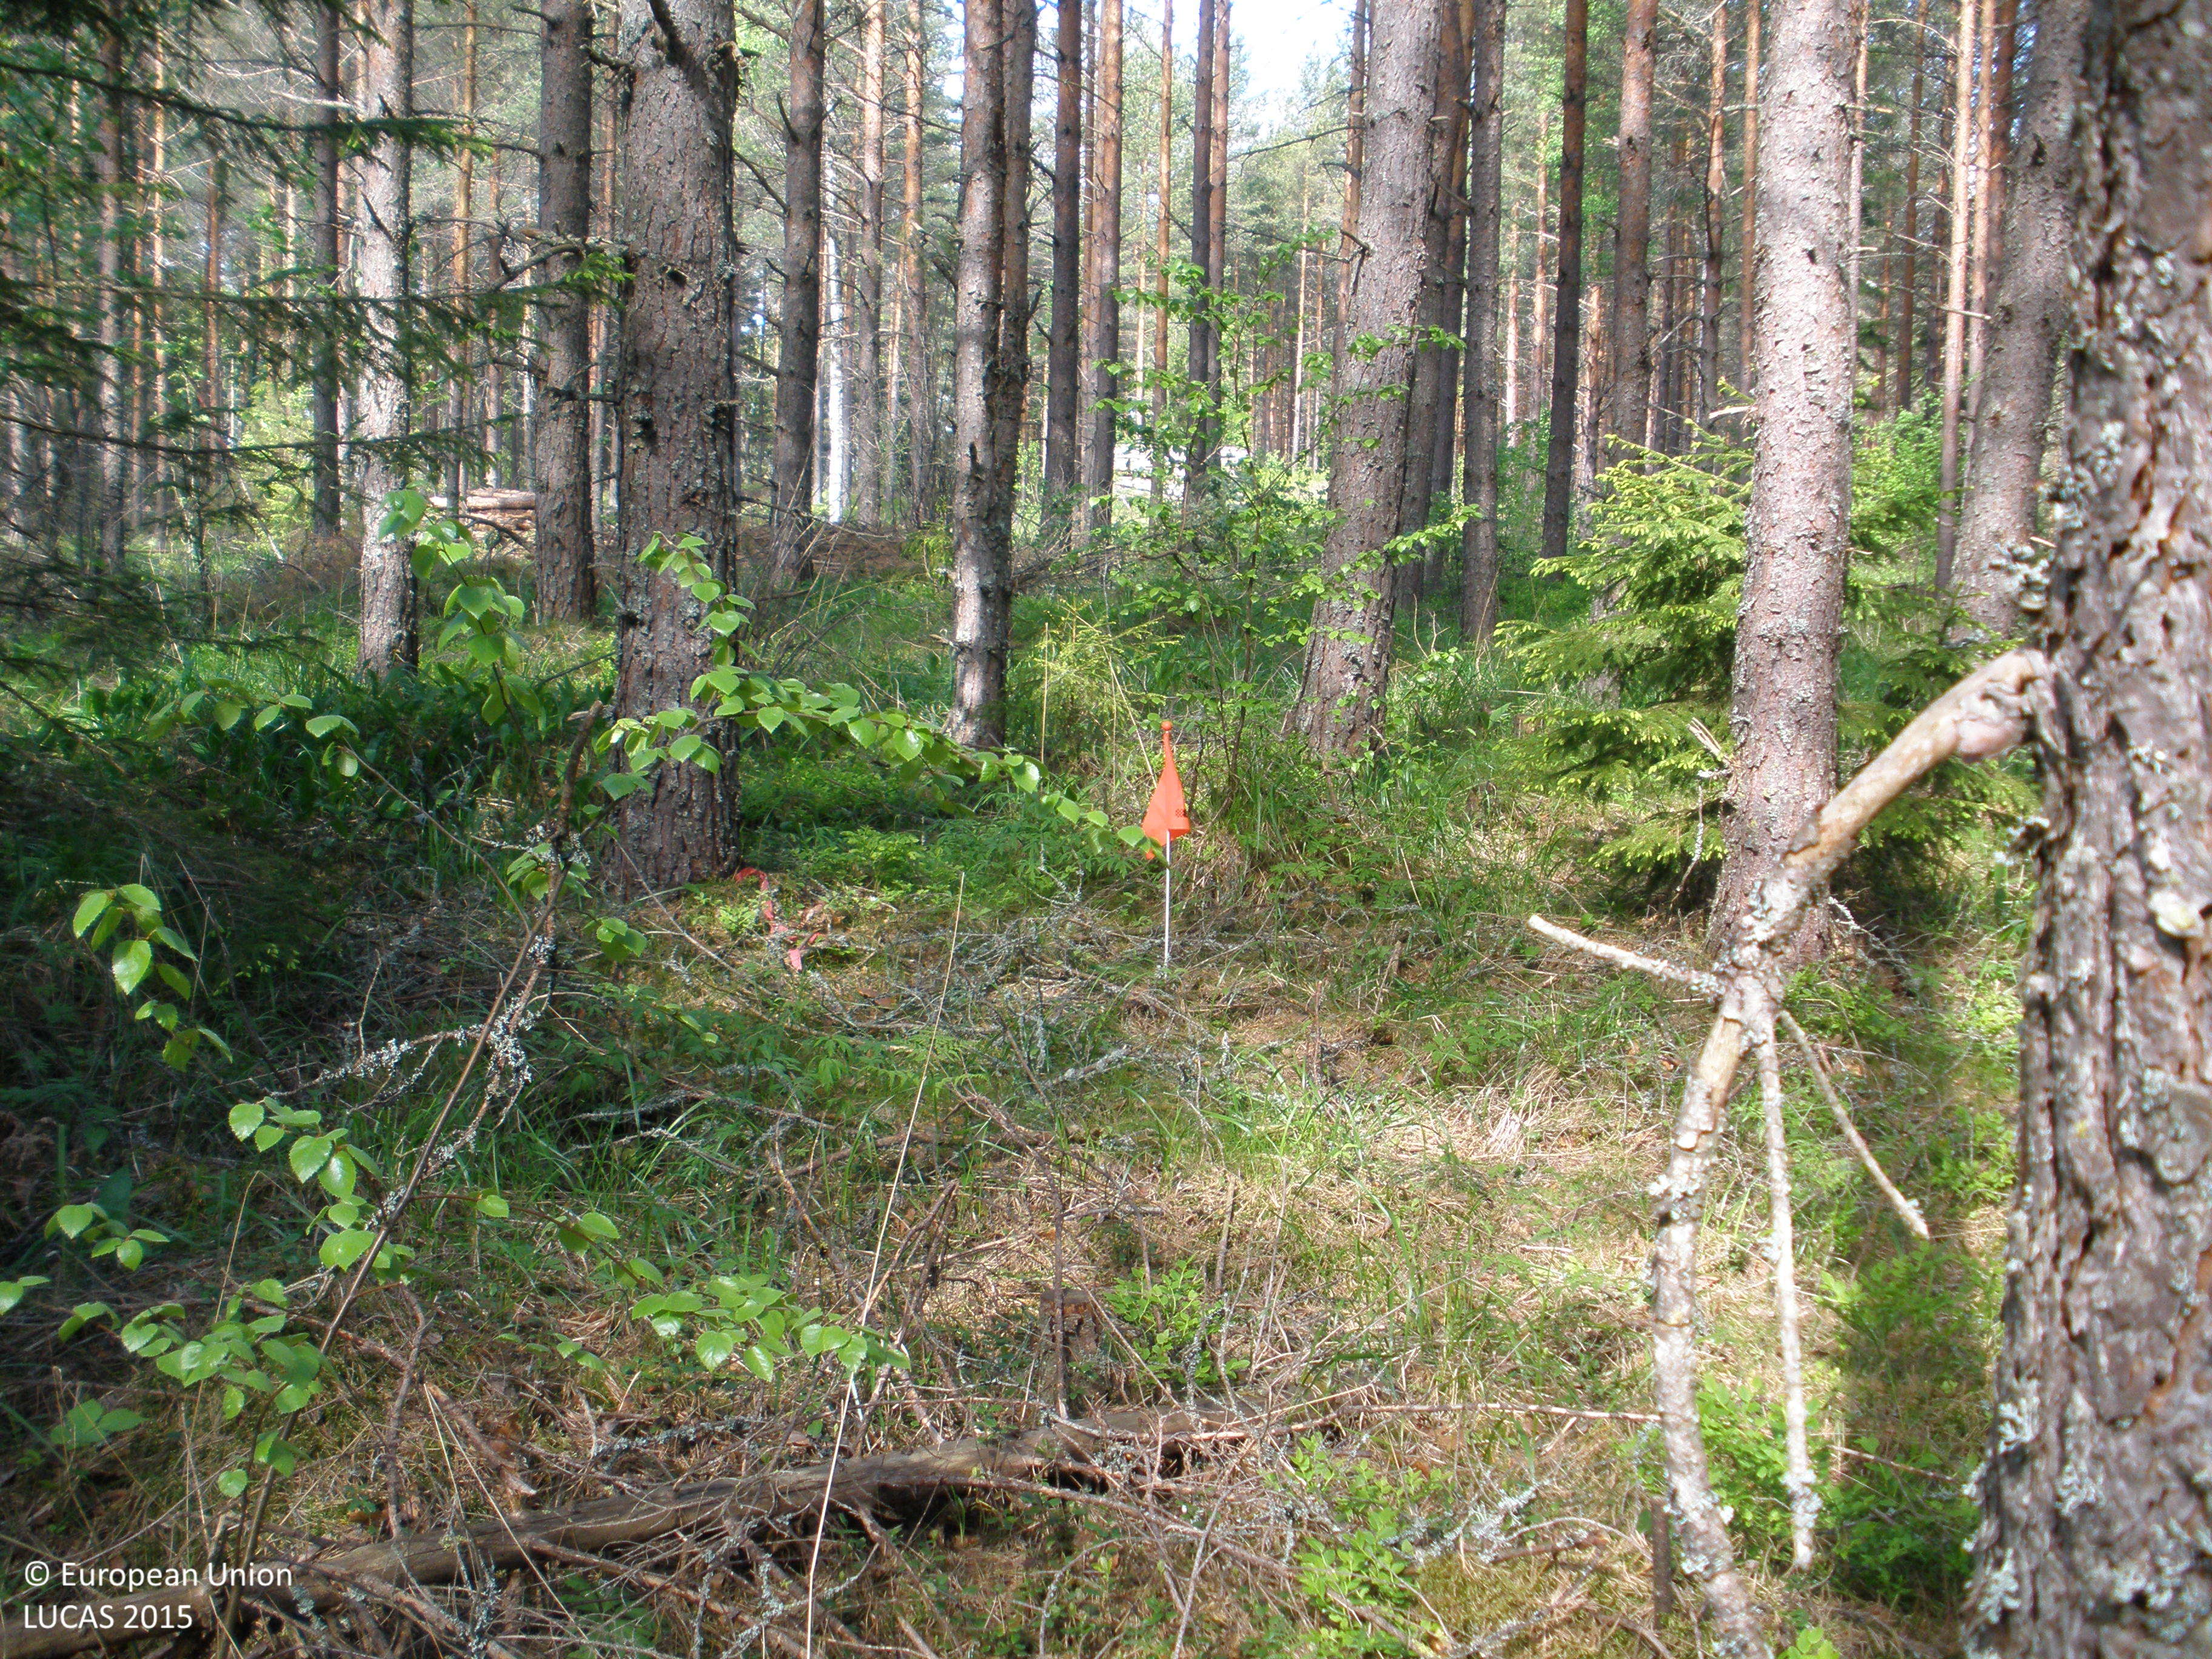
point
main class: Woodland
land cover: Pine dominated coniferous woodland
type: boreal forest
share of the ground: > 75 %
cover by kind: coniferous forest trees 80 %, lichens and mosses 10 %, broadleaved forest trees 5 %, herbaceous plants 5 %
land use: Forestry
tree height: > 5 m
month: June
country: FI
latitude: 60.7585
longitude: 24.0237
